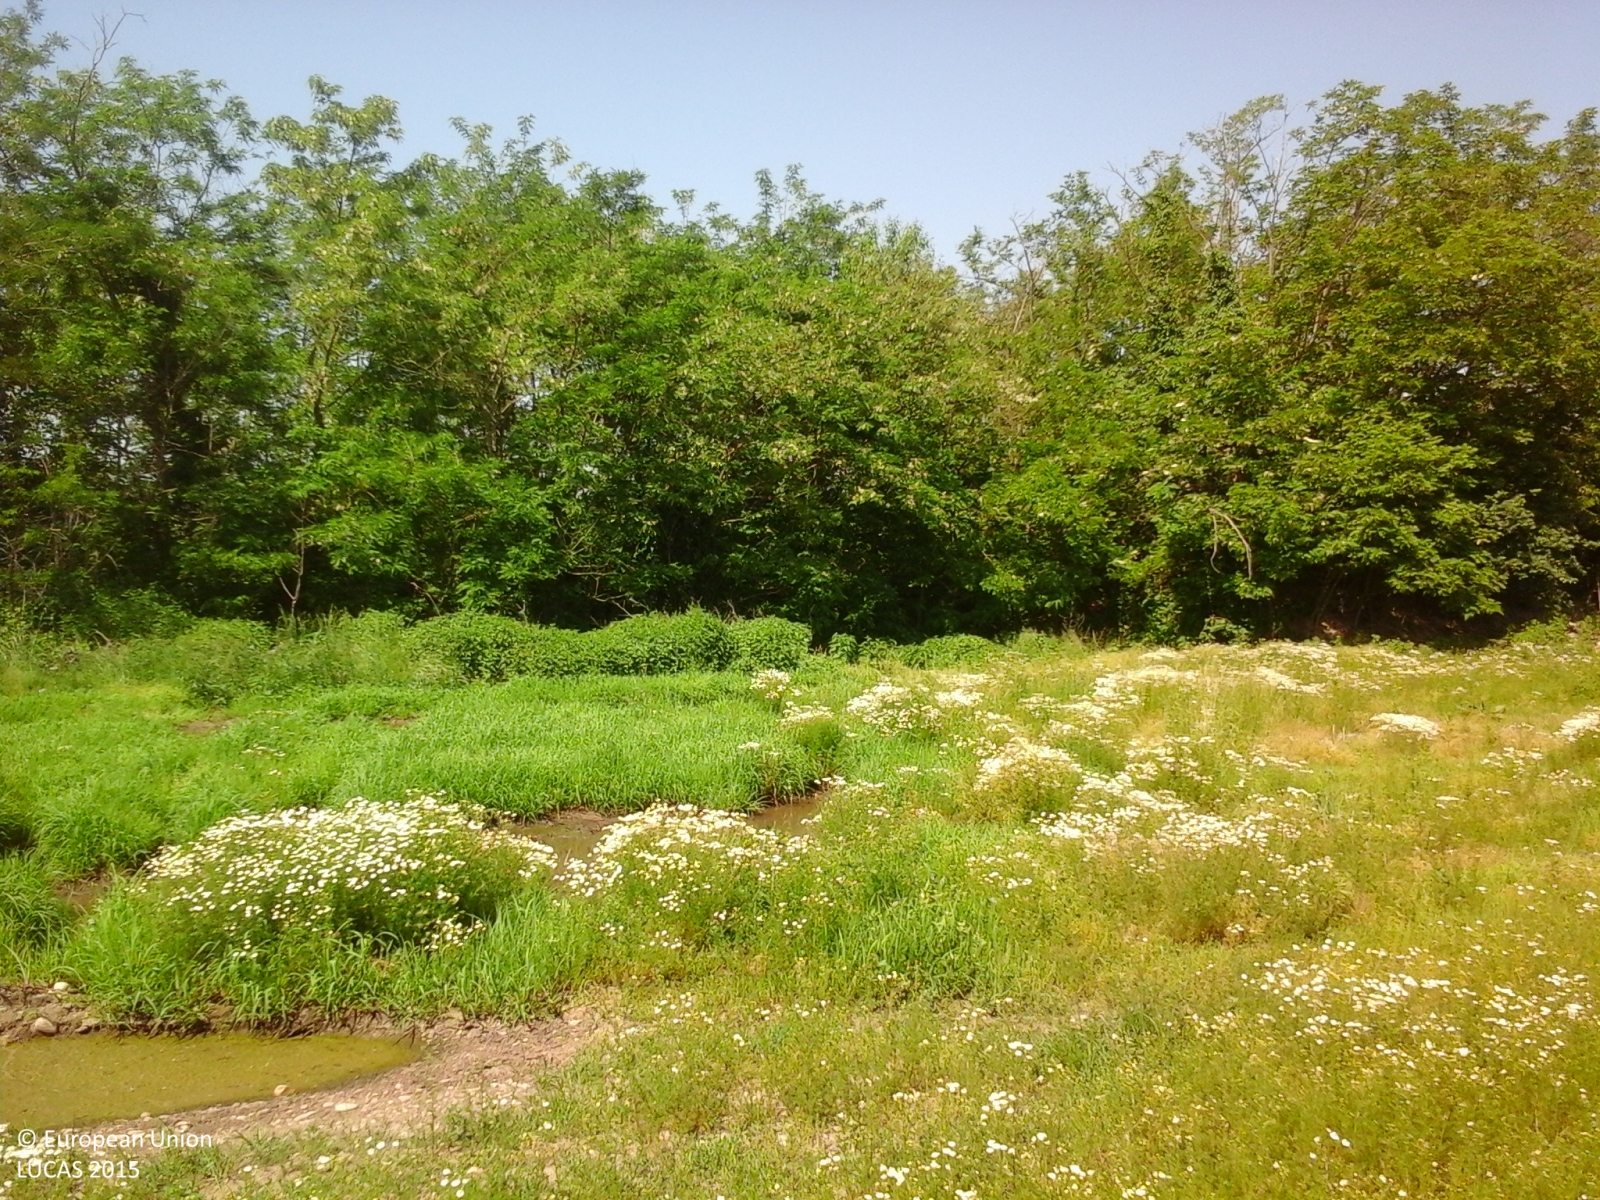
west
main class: Grassland
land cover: Grassland without tree/shrub cover
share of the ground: > 75 %
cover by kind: herbaceous plants 100 %
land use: Agriculture (excluding fallow land and kitchen gardens)
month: May
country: IT
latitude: 45.5670
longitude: 8.5801
